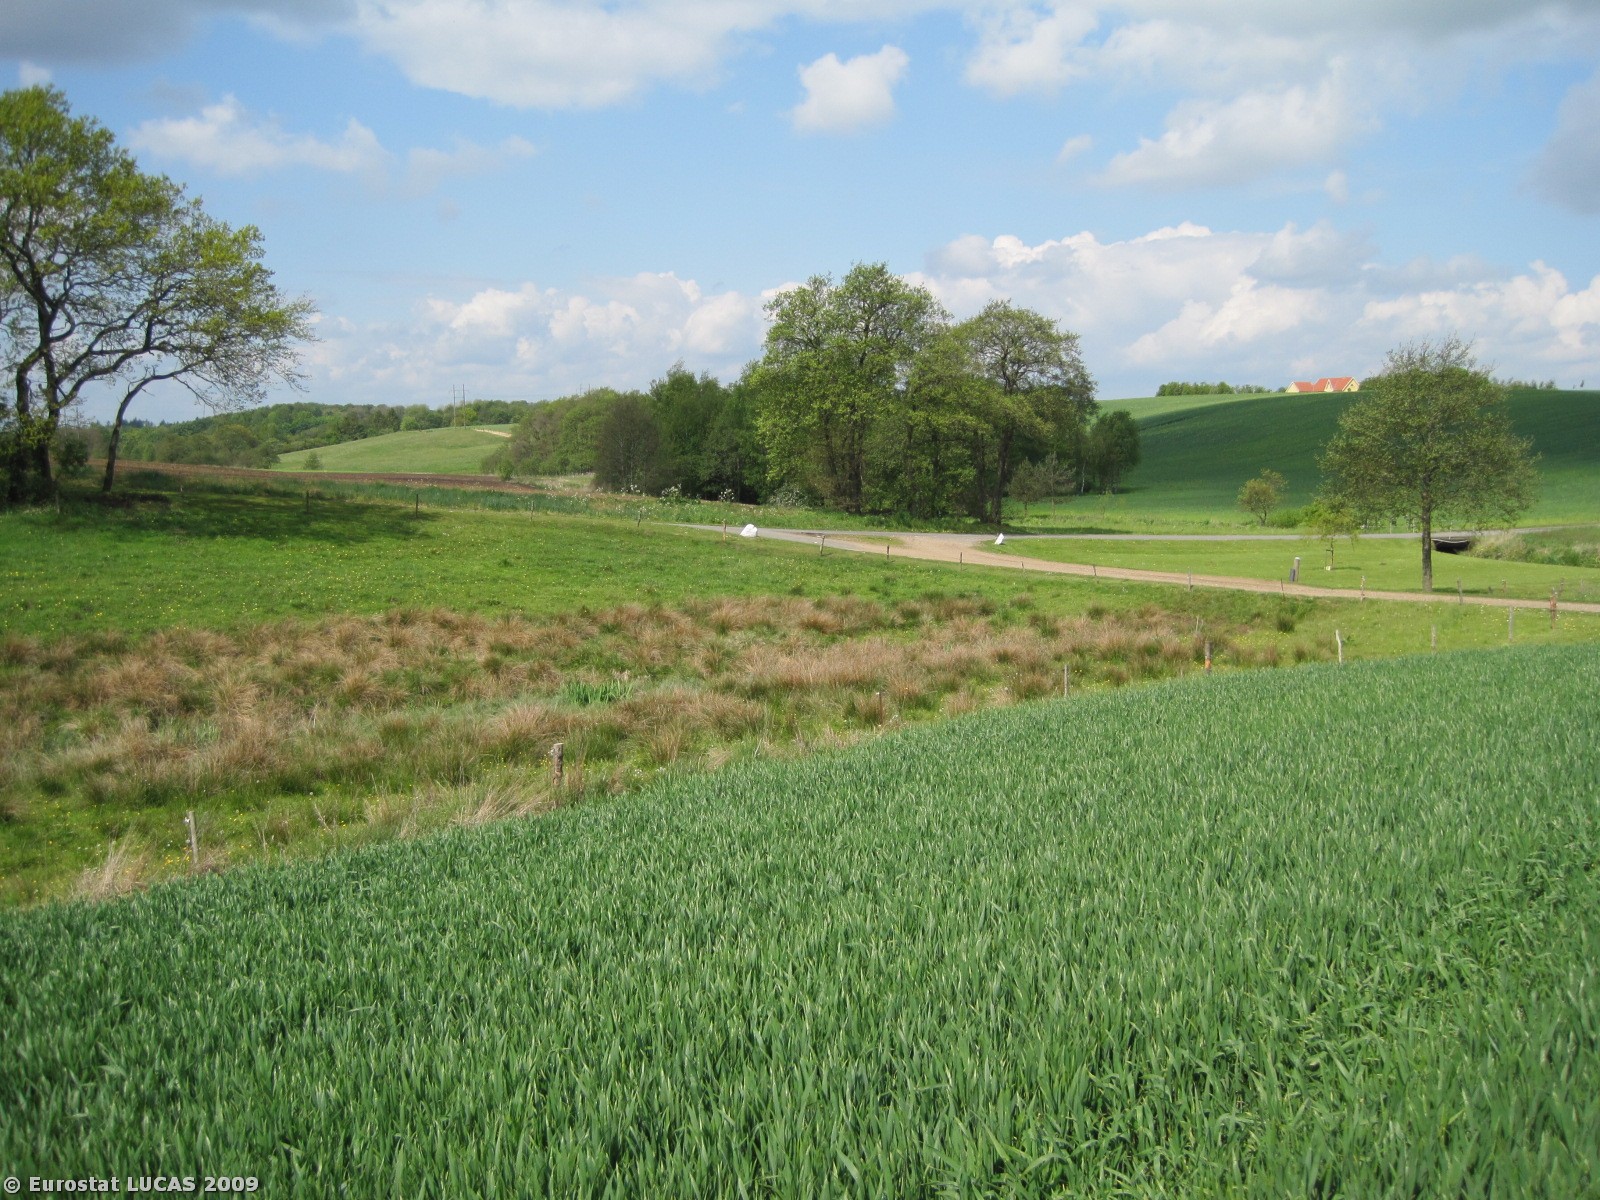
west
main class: Cropland
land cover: Common wheat
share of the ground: > 75 %
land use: Agriculture (excluding fallow land and kitchen gardens)
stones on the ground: < 10 %
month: May
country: DK
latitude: 56.3133
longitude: 9.7255
